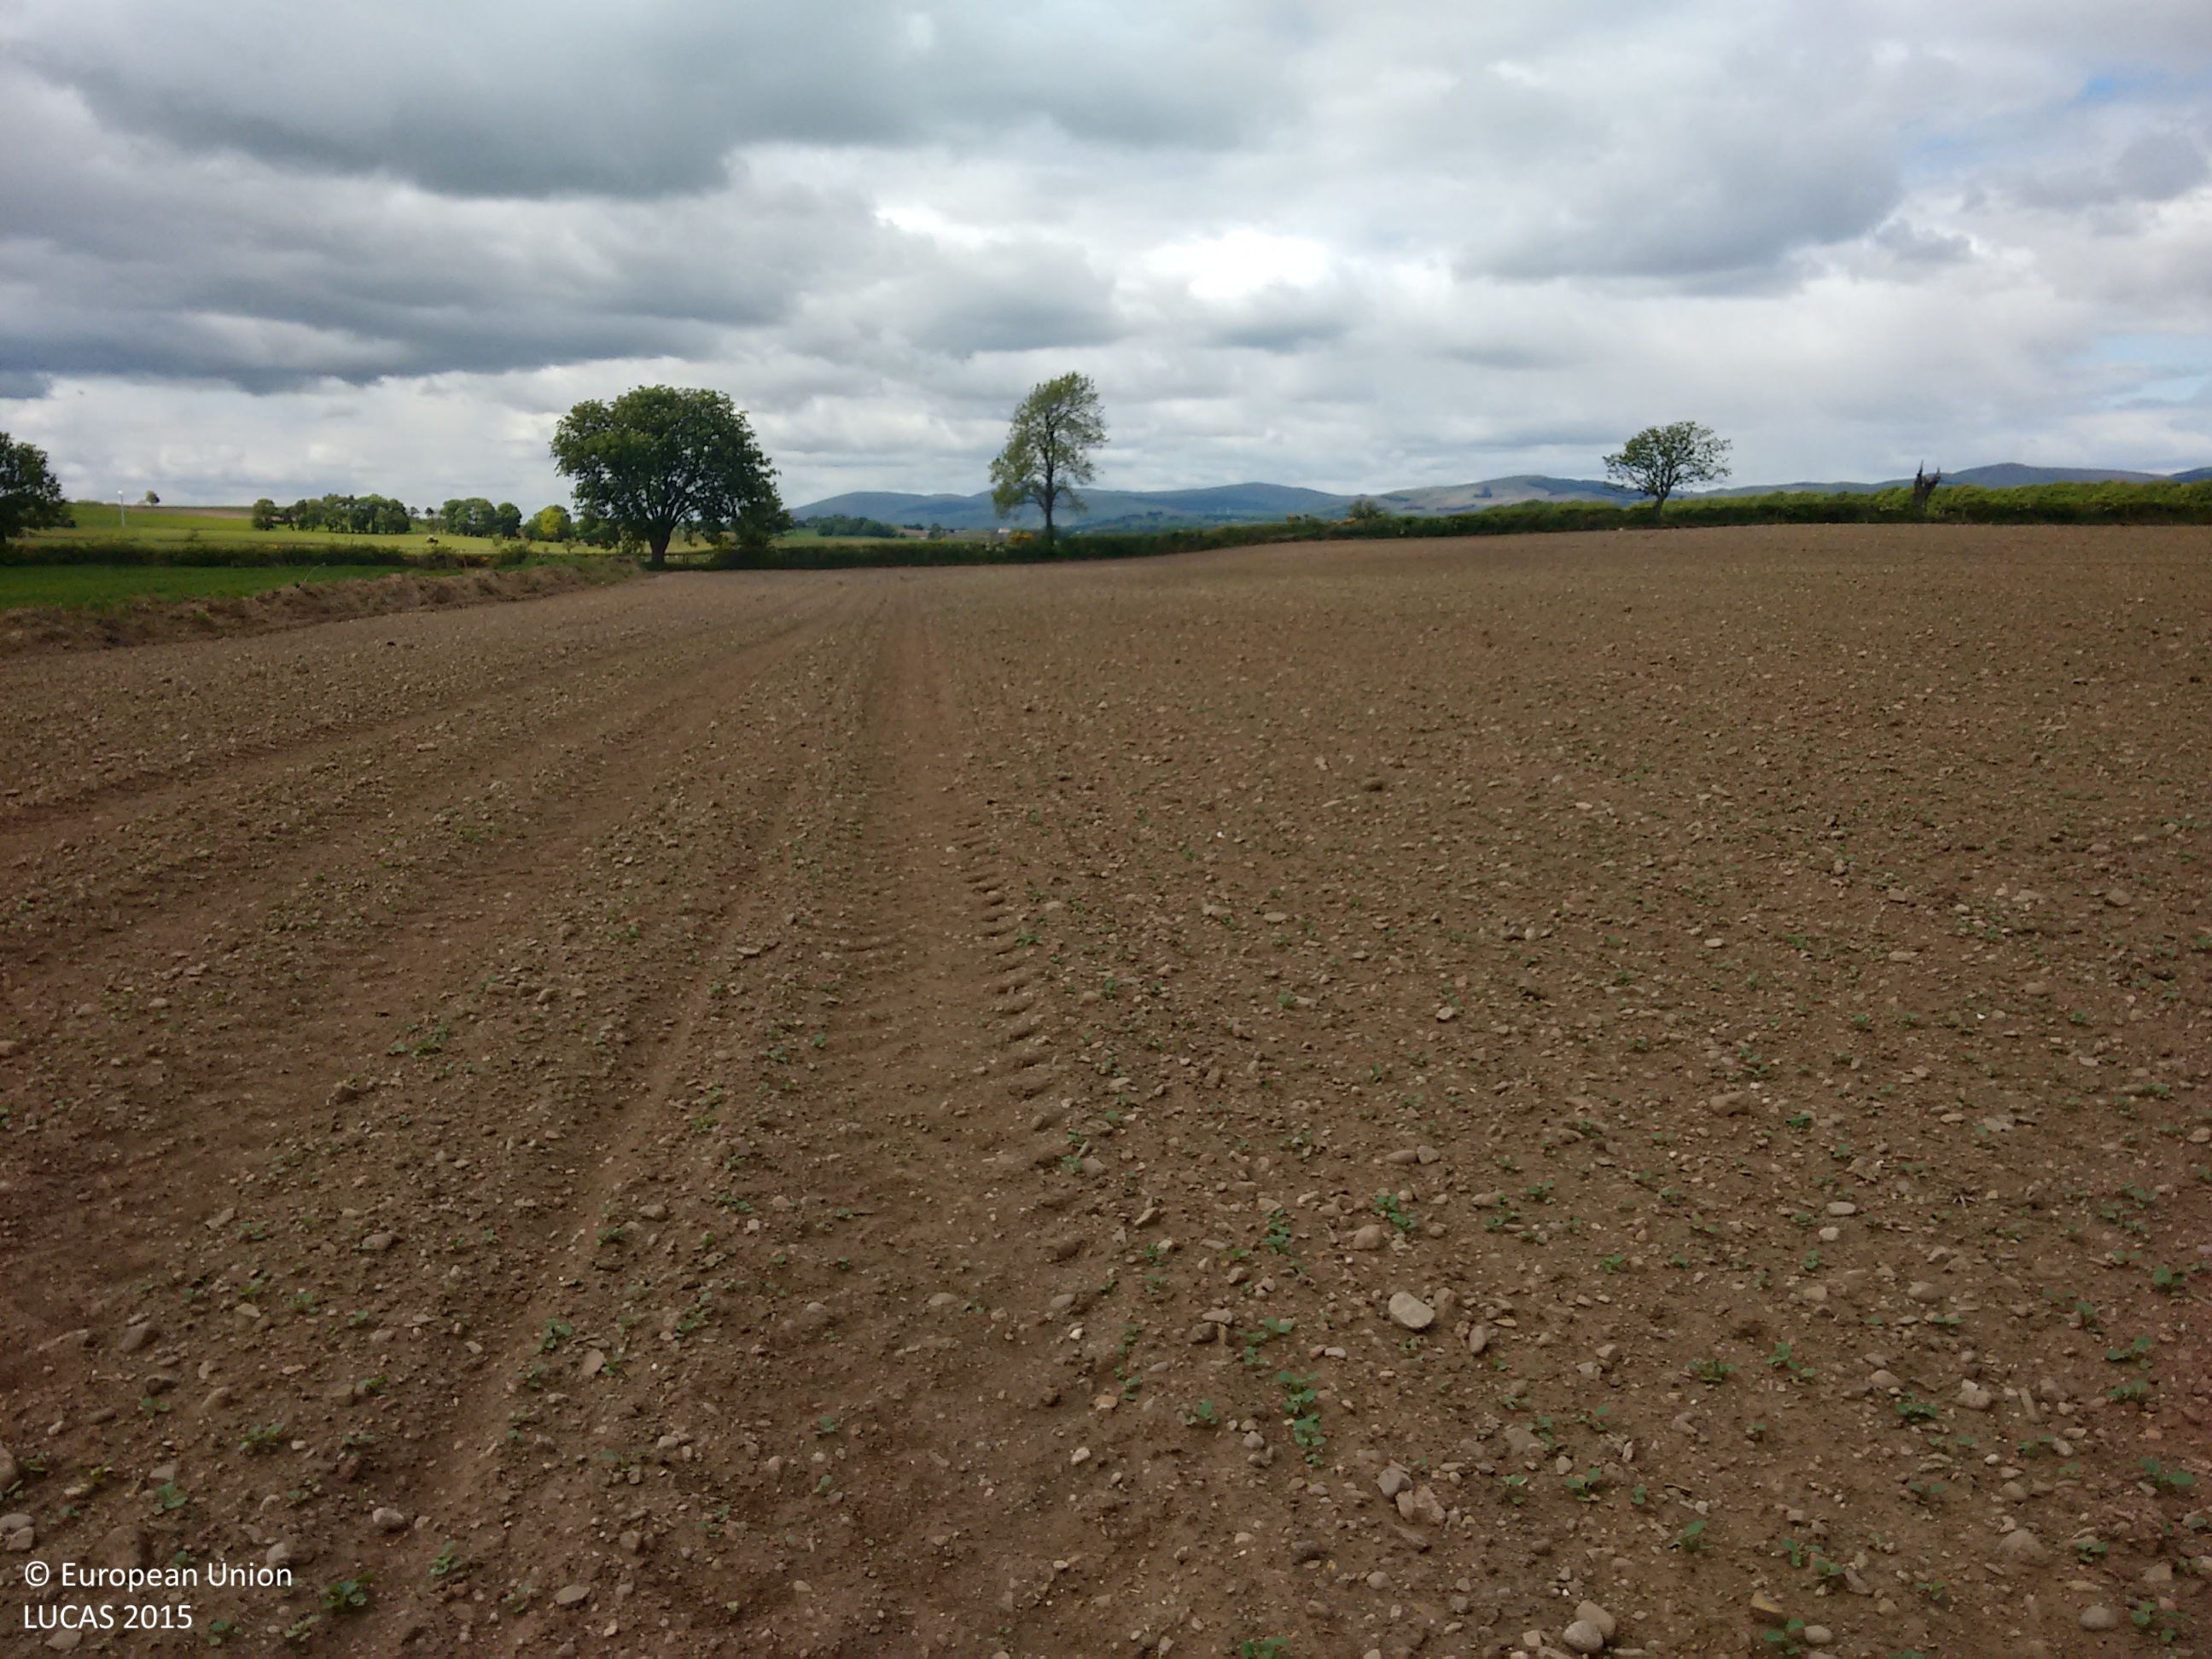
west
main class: Cropland
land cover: Rape and turnip rape
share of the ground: 10 - 25 %
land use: Agriculture (excluding fallow land and kitchen gardens)
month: June
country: GB
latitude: 56.1892
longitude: -3.4333
